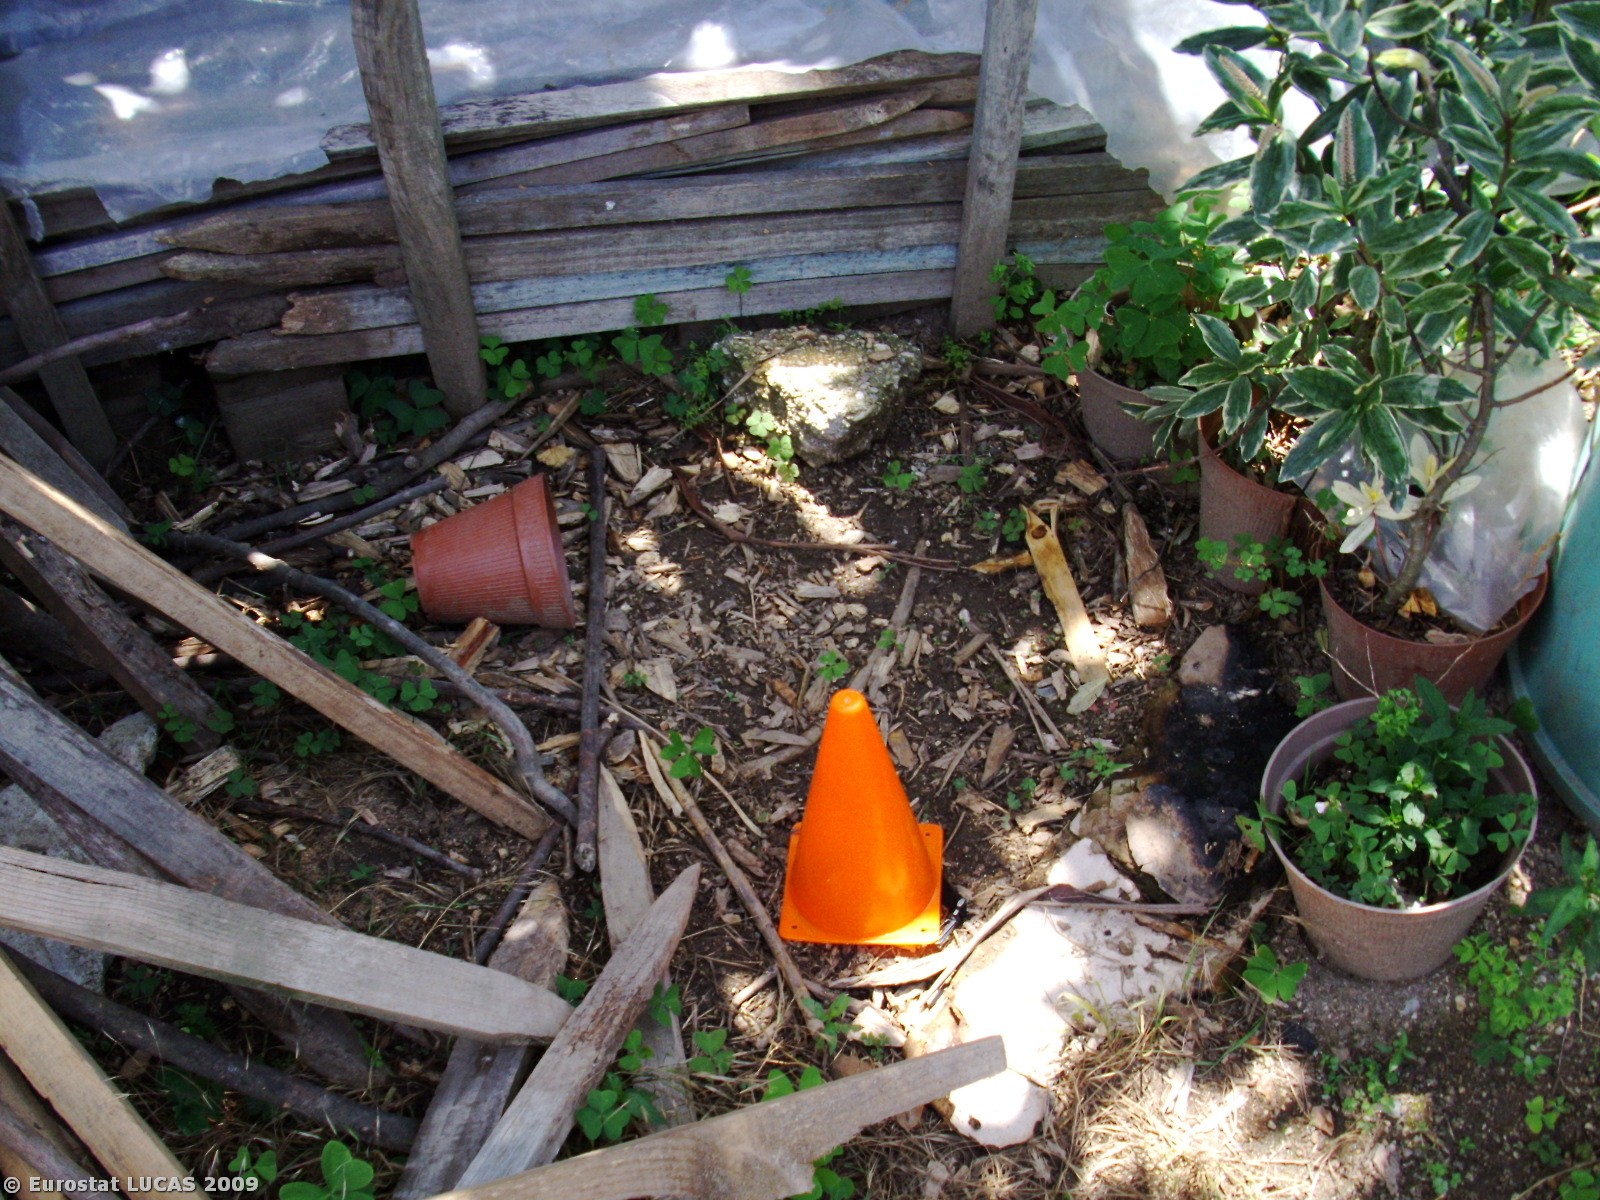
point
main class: Artificial land
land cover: Greenhouses
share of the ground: 25 - 50 %
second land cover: Nurseries
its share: 25 - 50 %
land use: Kitchen garden
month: June
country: PT
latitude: 41.4923
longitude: -8.5674
